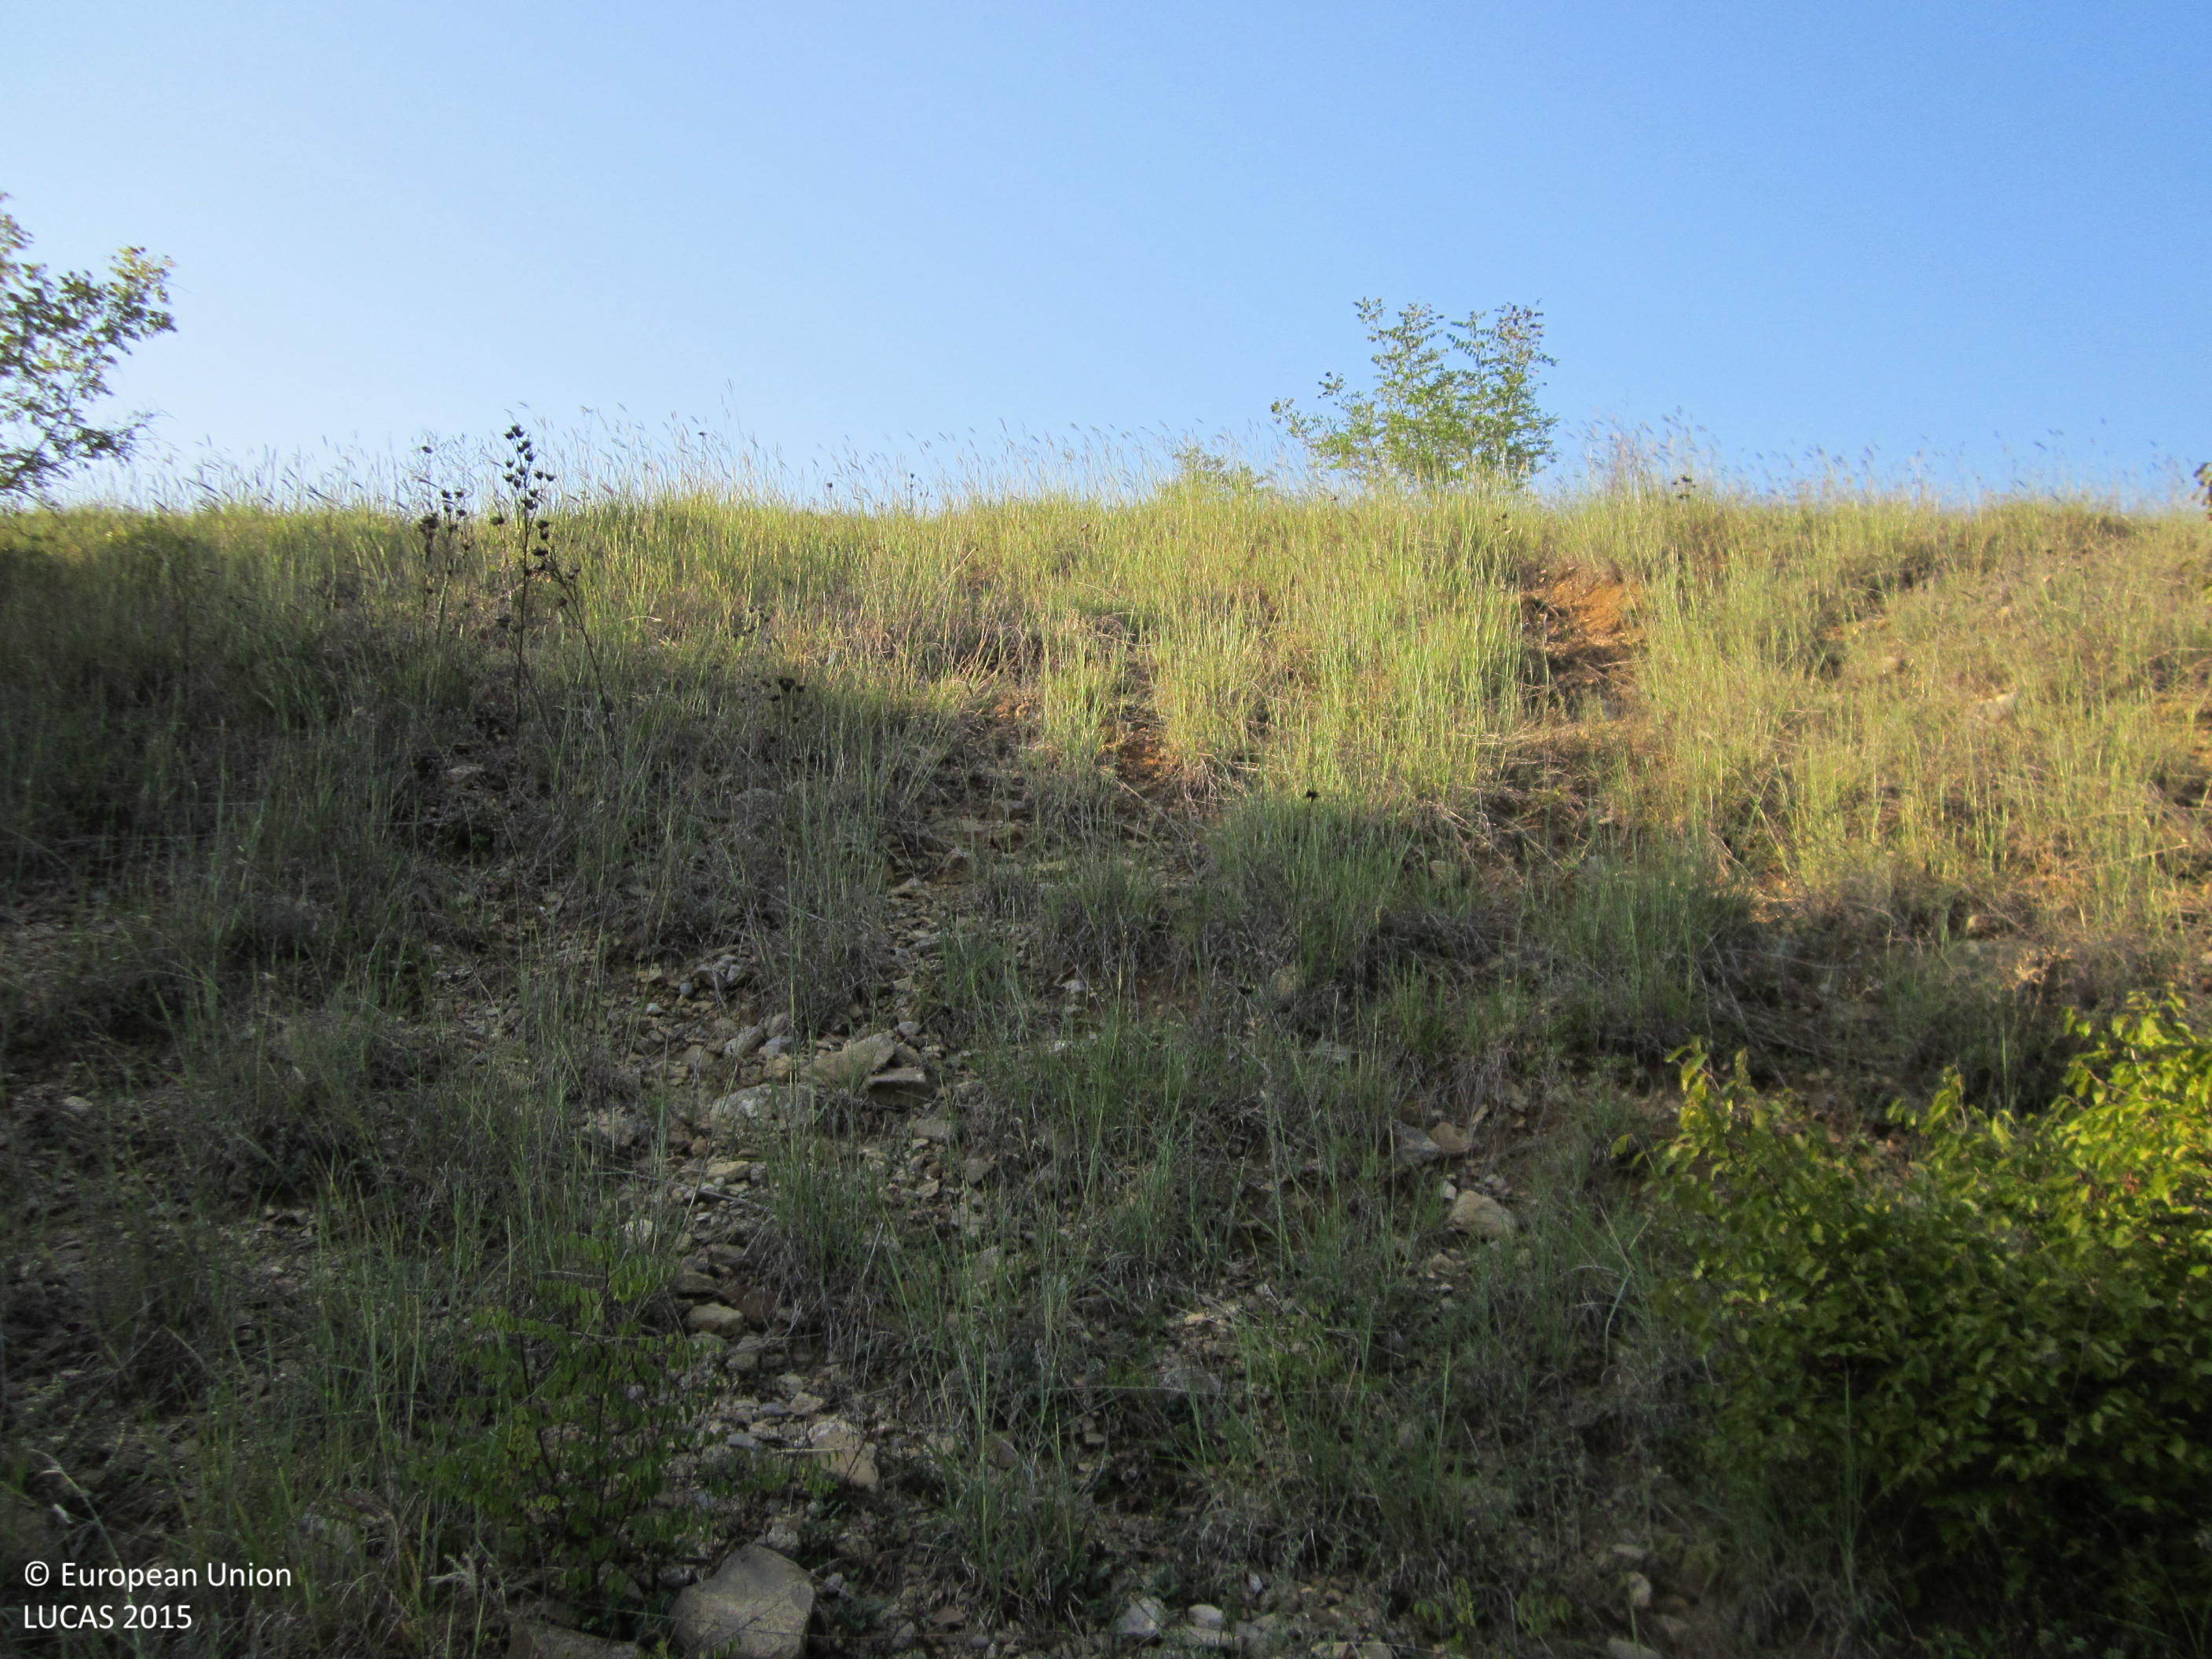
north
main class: Woodland
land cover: Broadleaved woodland
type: mesophytic deciduous forest
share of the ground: > 75 %
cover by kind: broadleaved forest trees 100 %
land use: Forestry
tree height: > 5 m
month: September
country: BG
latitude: 42.9011
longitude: 27.1999
